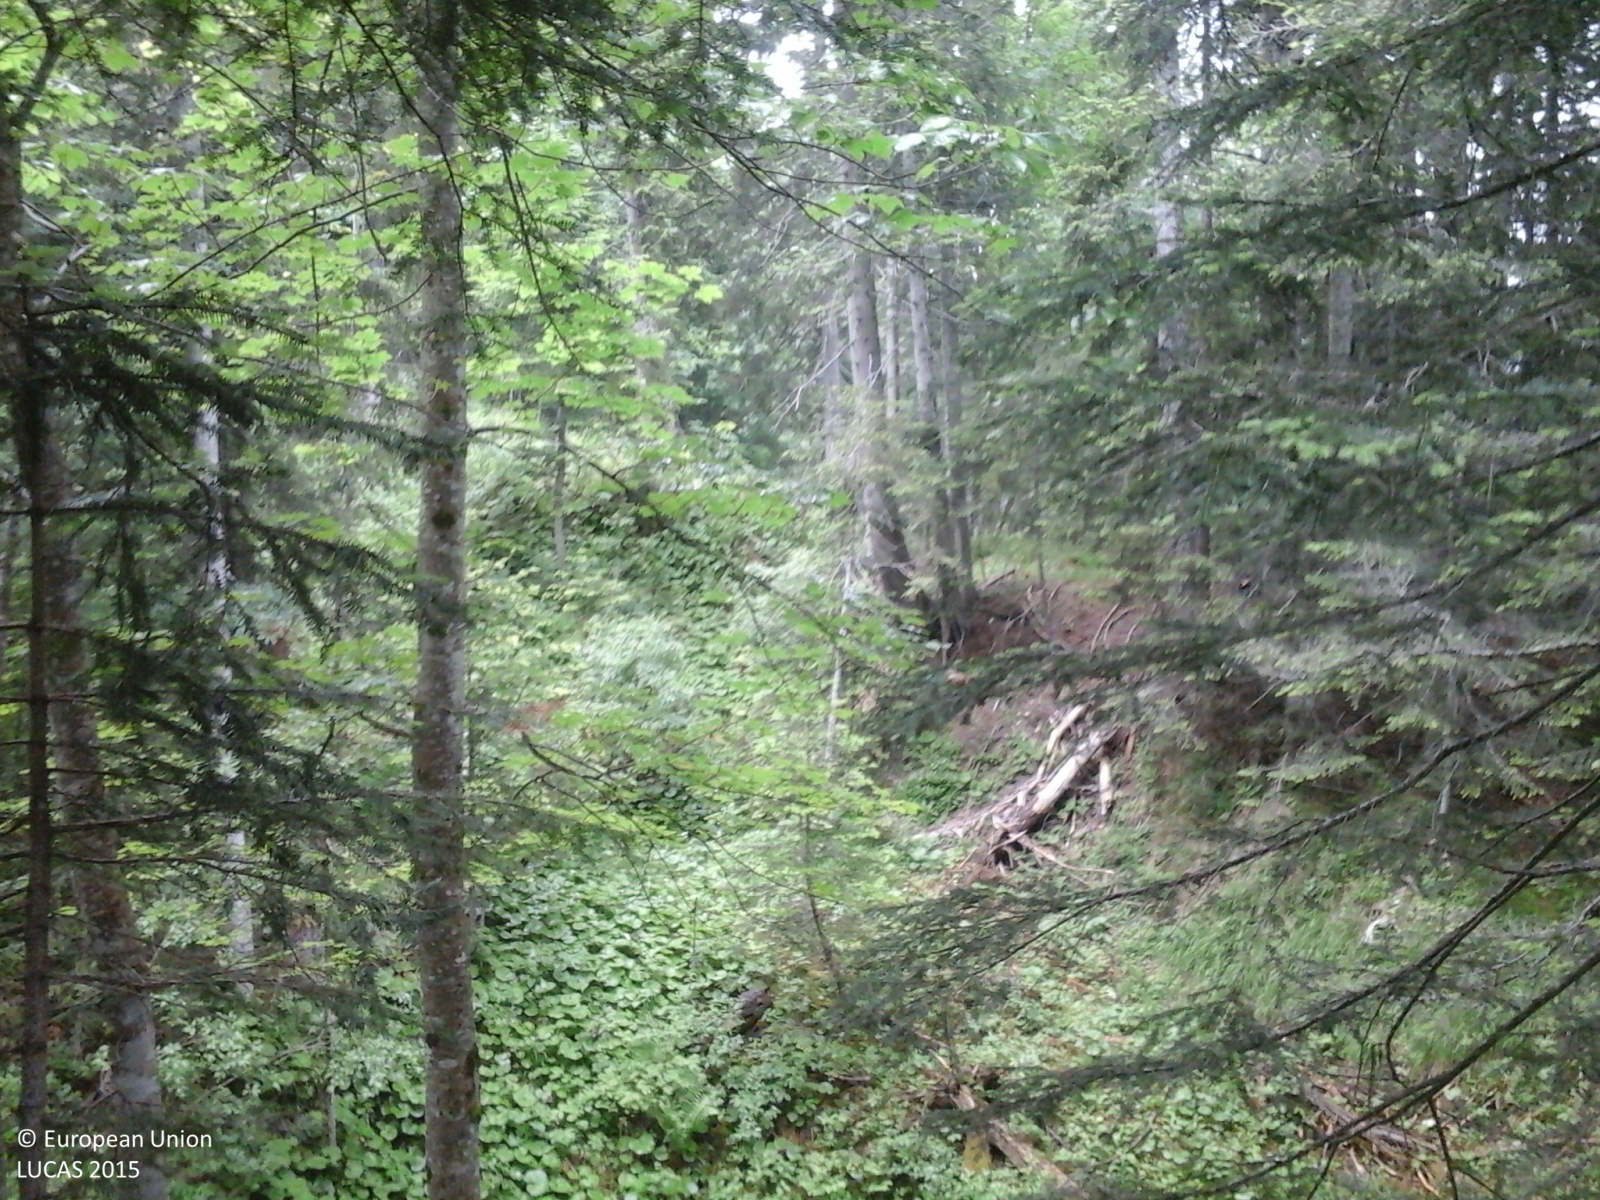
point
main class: Woodland
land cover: Other coniferous woodland
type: alpine coniferous forest
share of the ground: > 75 %
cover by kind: coniferous forest trees 100 %
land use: Forestry
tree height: > 5 m
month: June
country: IT
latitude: 46.5745
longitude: 12.4896
